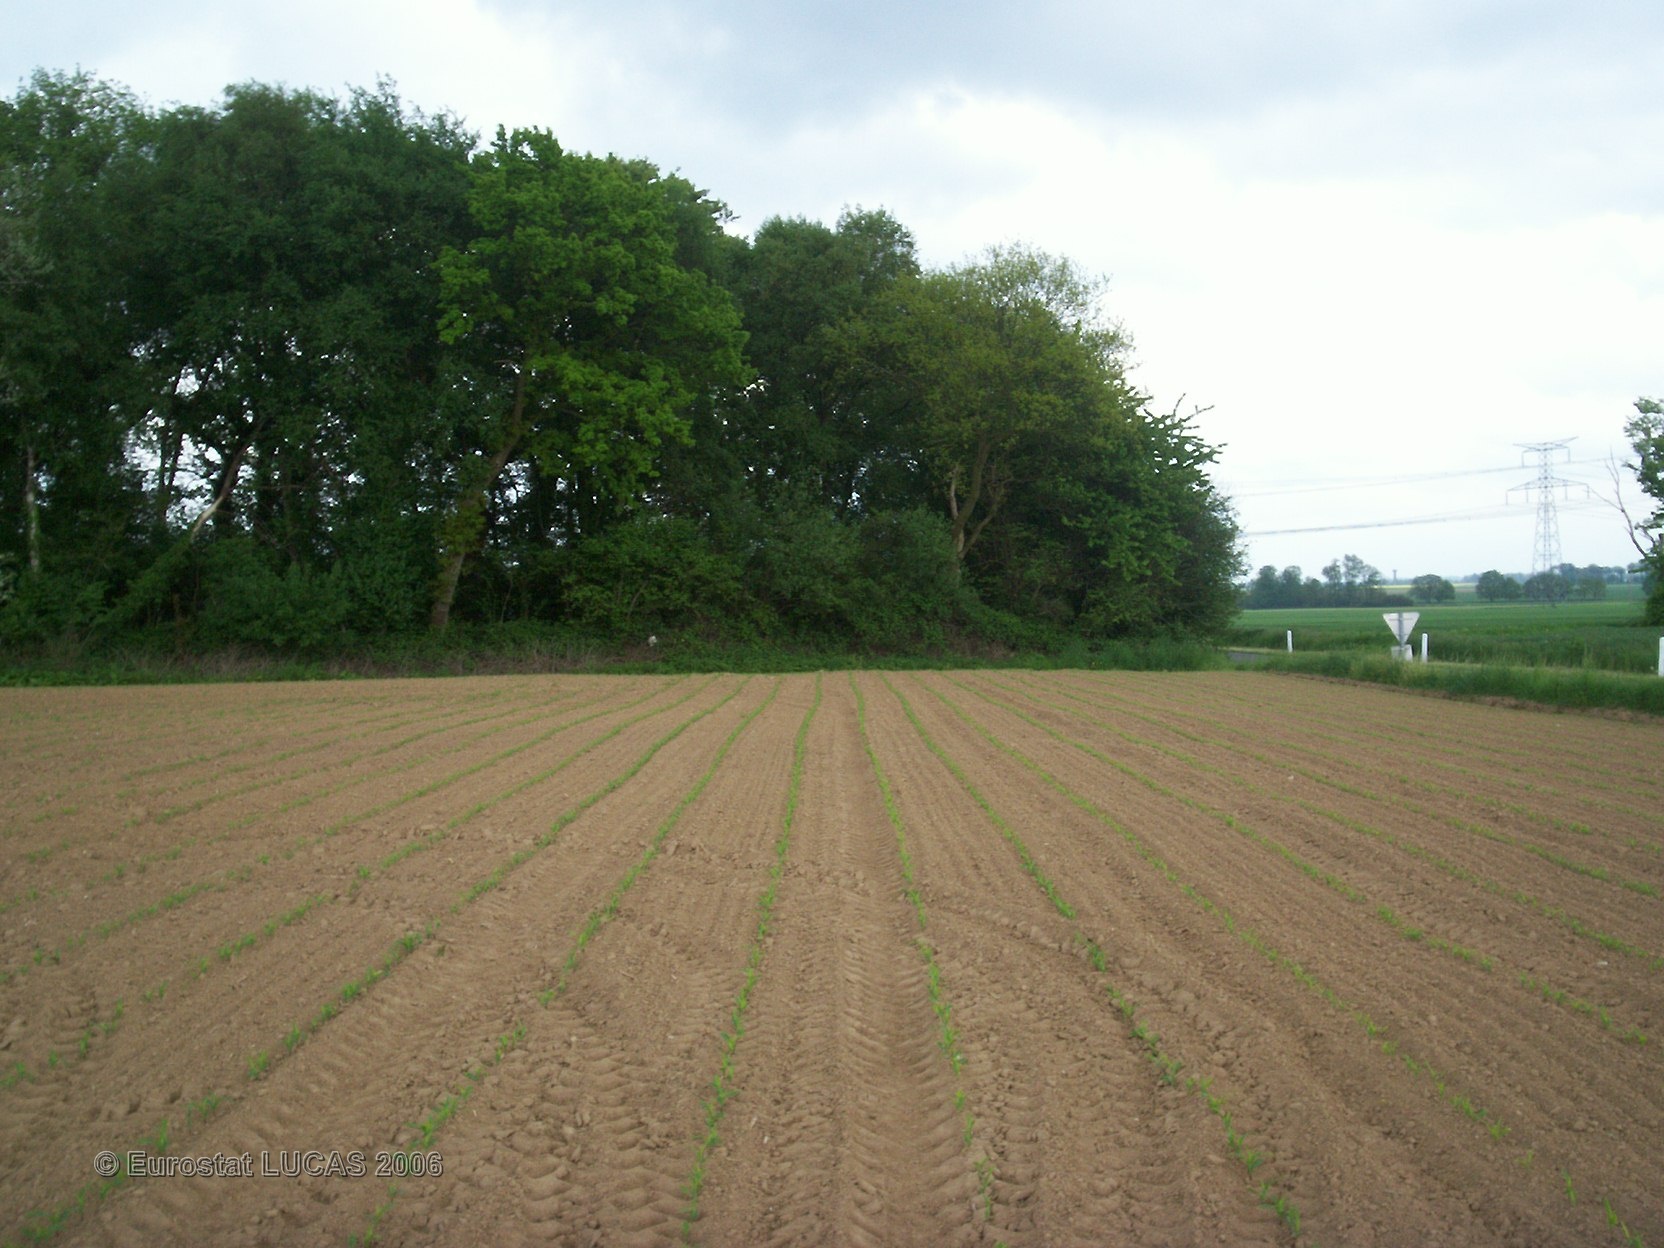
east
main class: Cropland
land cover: Maize
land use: Agriculture (excluding fallow land and kitchen gardens)
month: May
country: FR
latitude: 49.8108
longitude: 0.7900
